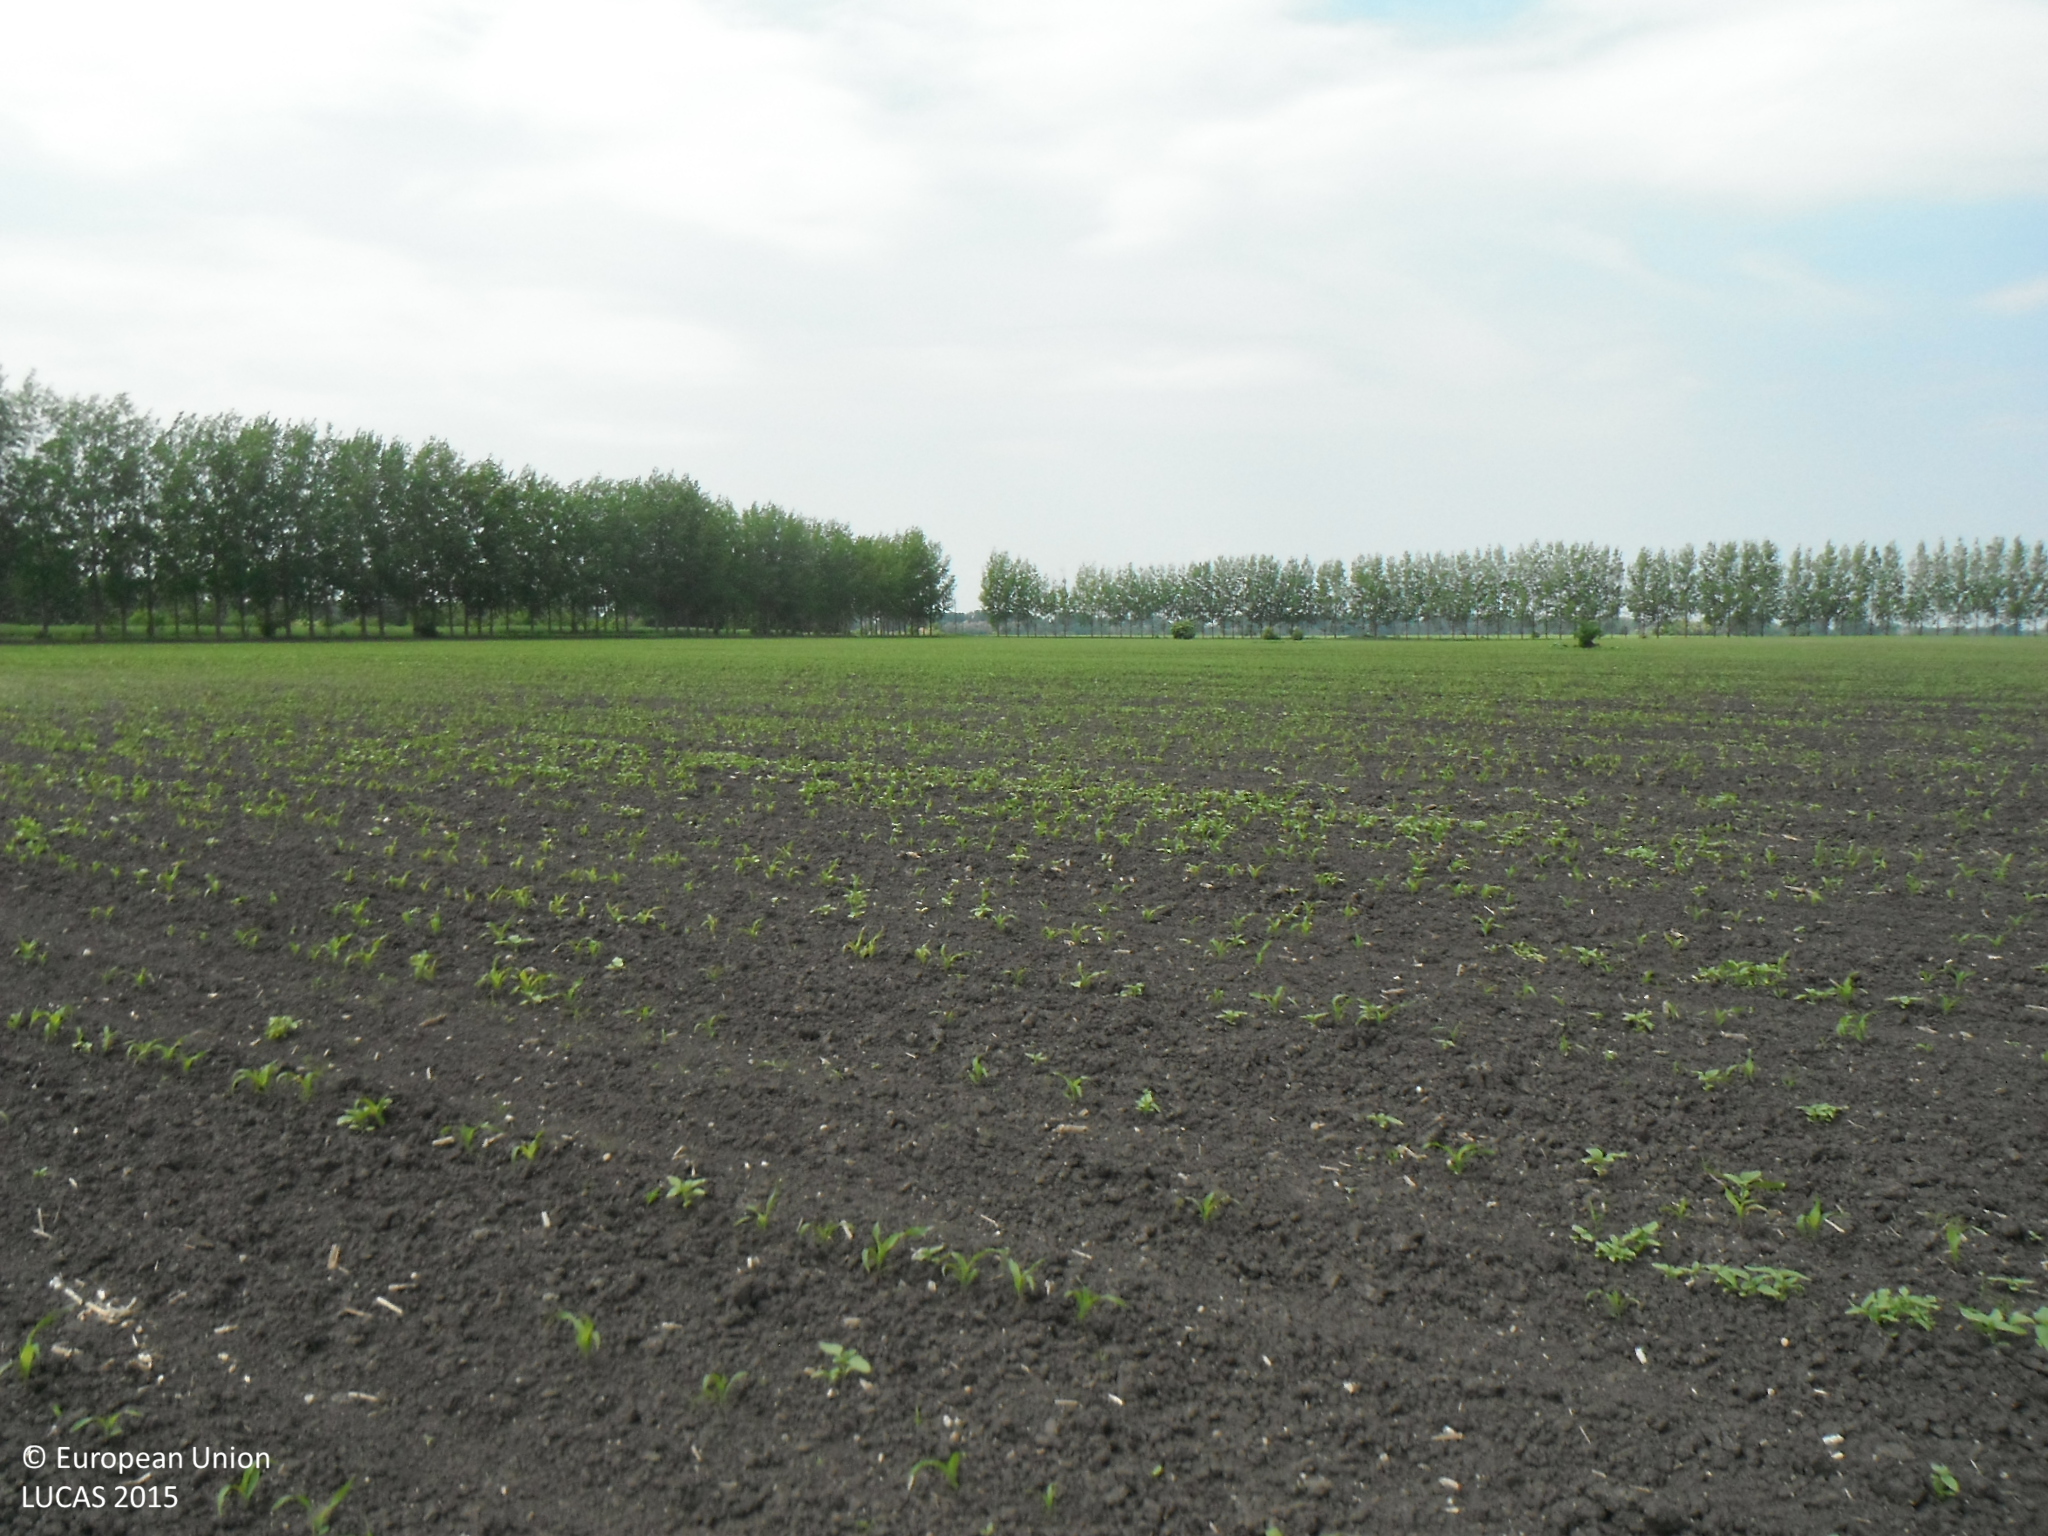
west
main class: Cropland
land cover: Maize
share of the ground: < 10 %
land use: Agriculture (excluding fallow land and kitchen gardens)
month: May
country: SK
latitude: 47.8620
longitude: 17.7231
